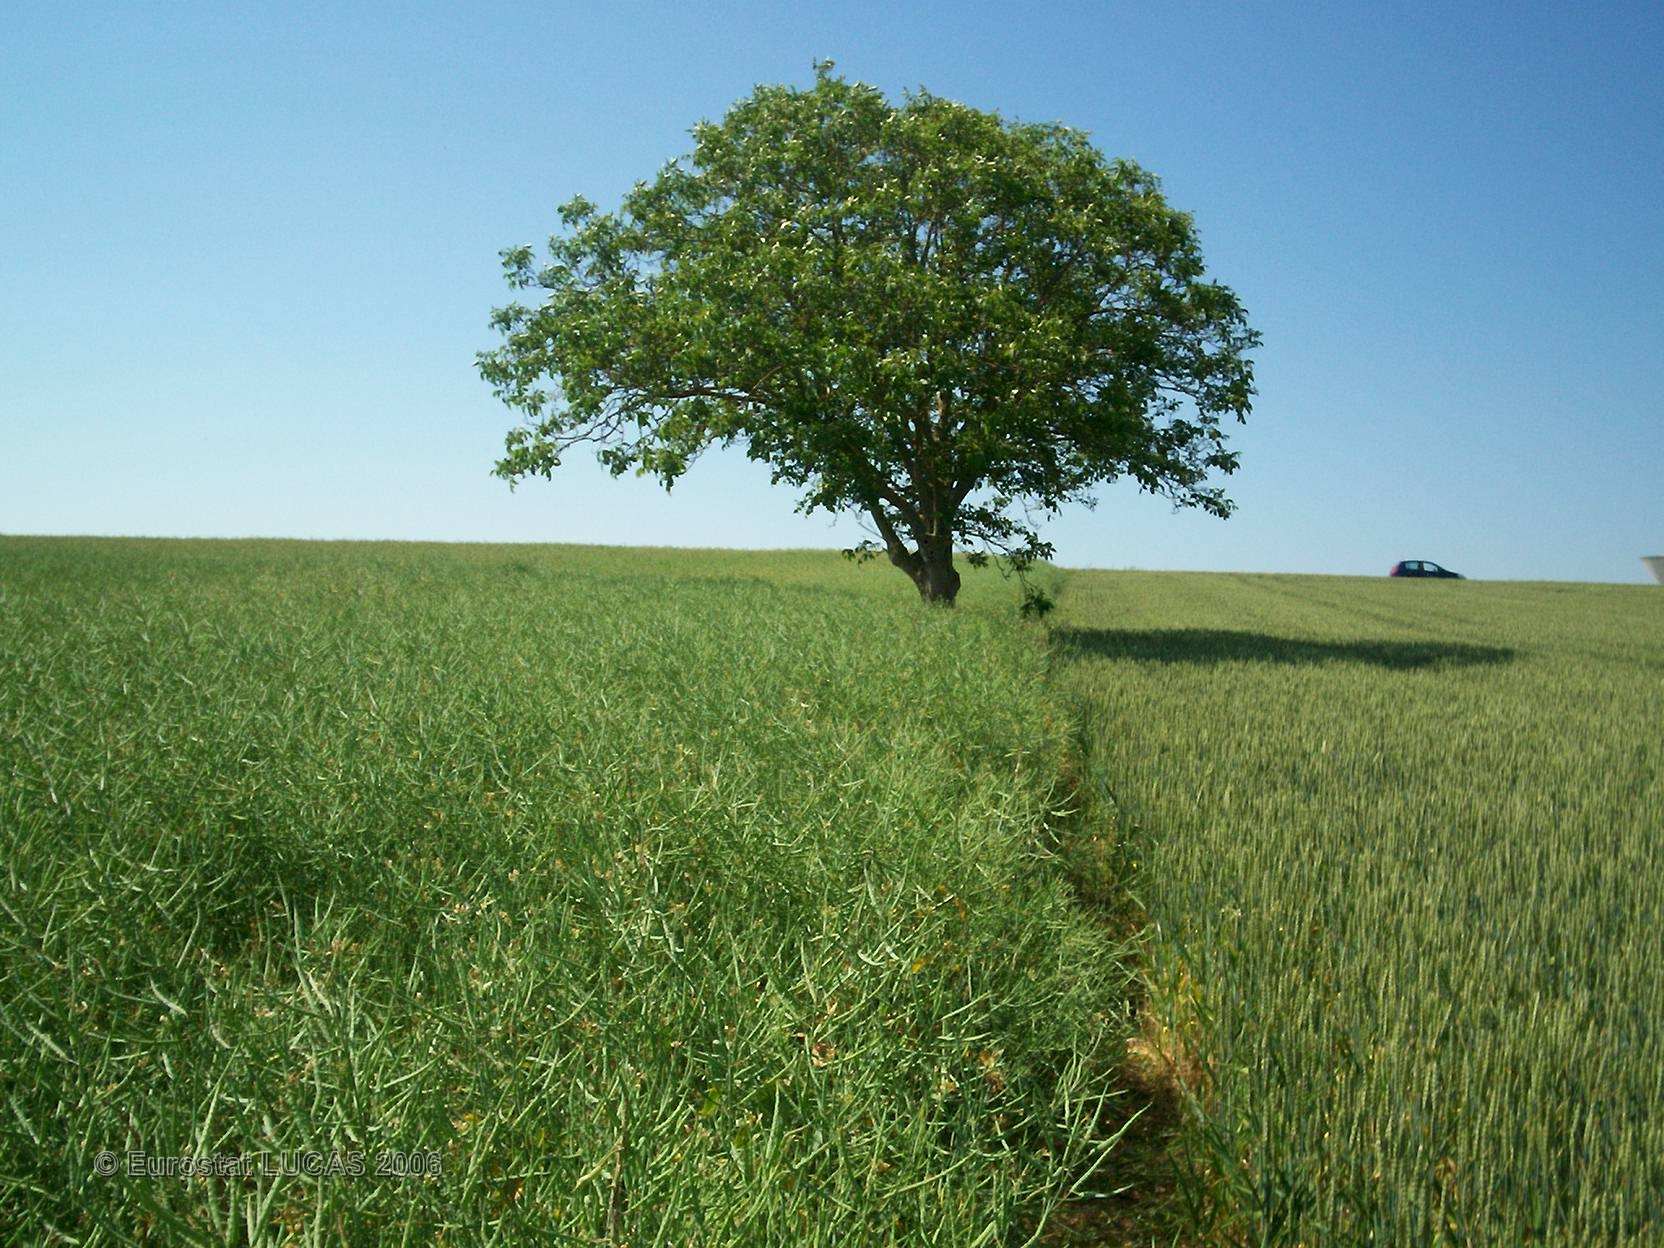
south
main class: Cropland
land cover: Rape and turnip rape
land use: Agriculture (excluding fallow land and kitchen gardens)
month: June
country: FR
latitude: 46.2408
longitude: -0.7793
